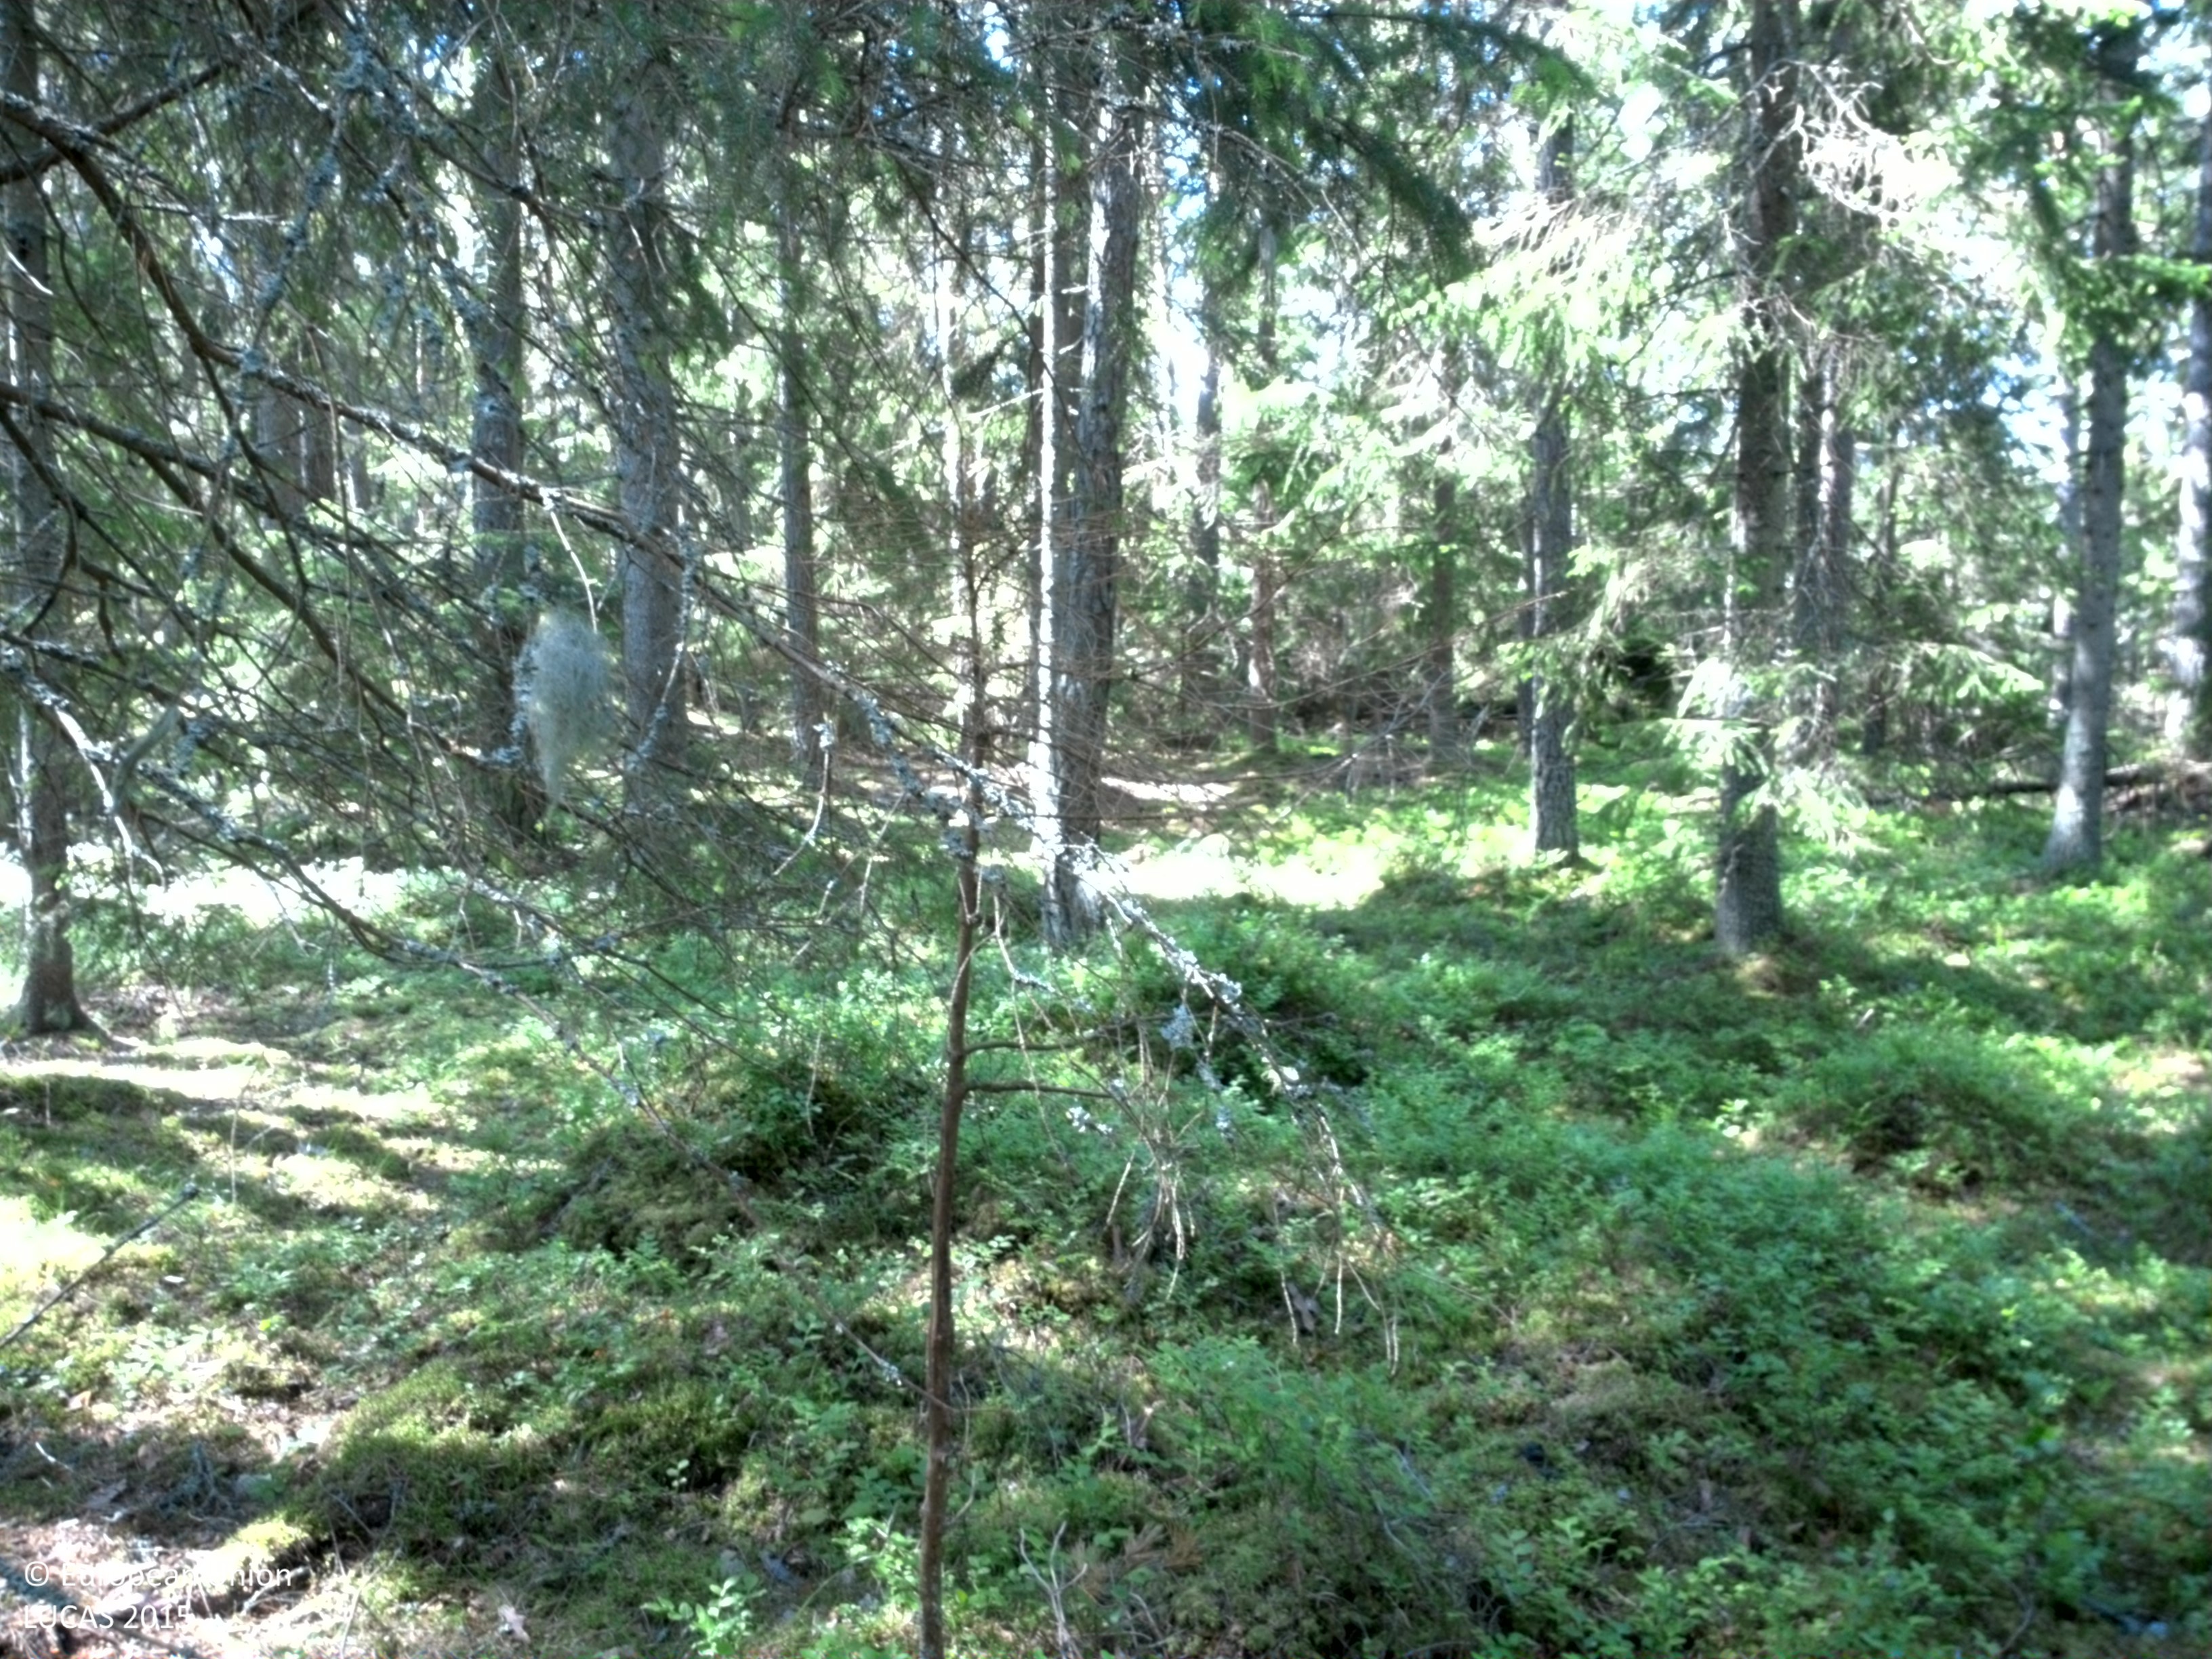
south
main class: Woodland
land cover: Other coniferous woodland
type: boreal forest
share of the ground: 25 - 50 %
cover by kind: coniferous forest trees 50 %, herbaceous plants 30 %, lichens and mosses 20 %
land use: Forestry
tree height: > 5 m
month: June
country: SE
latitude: 58.5532
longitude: 15.6137
